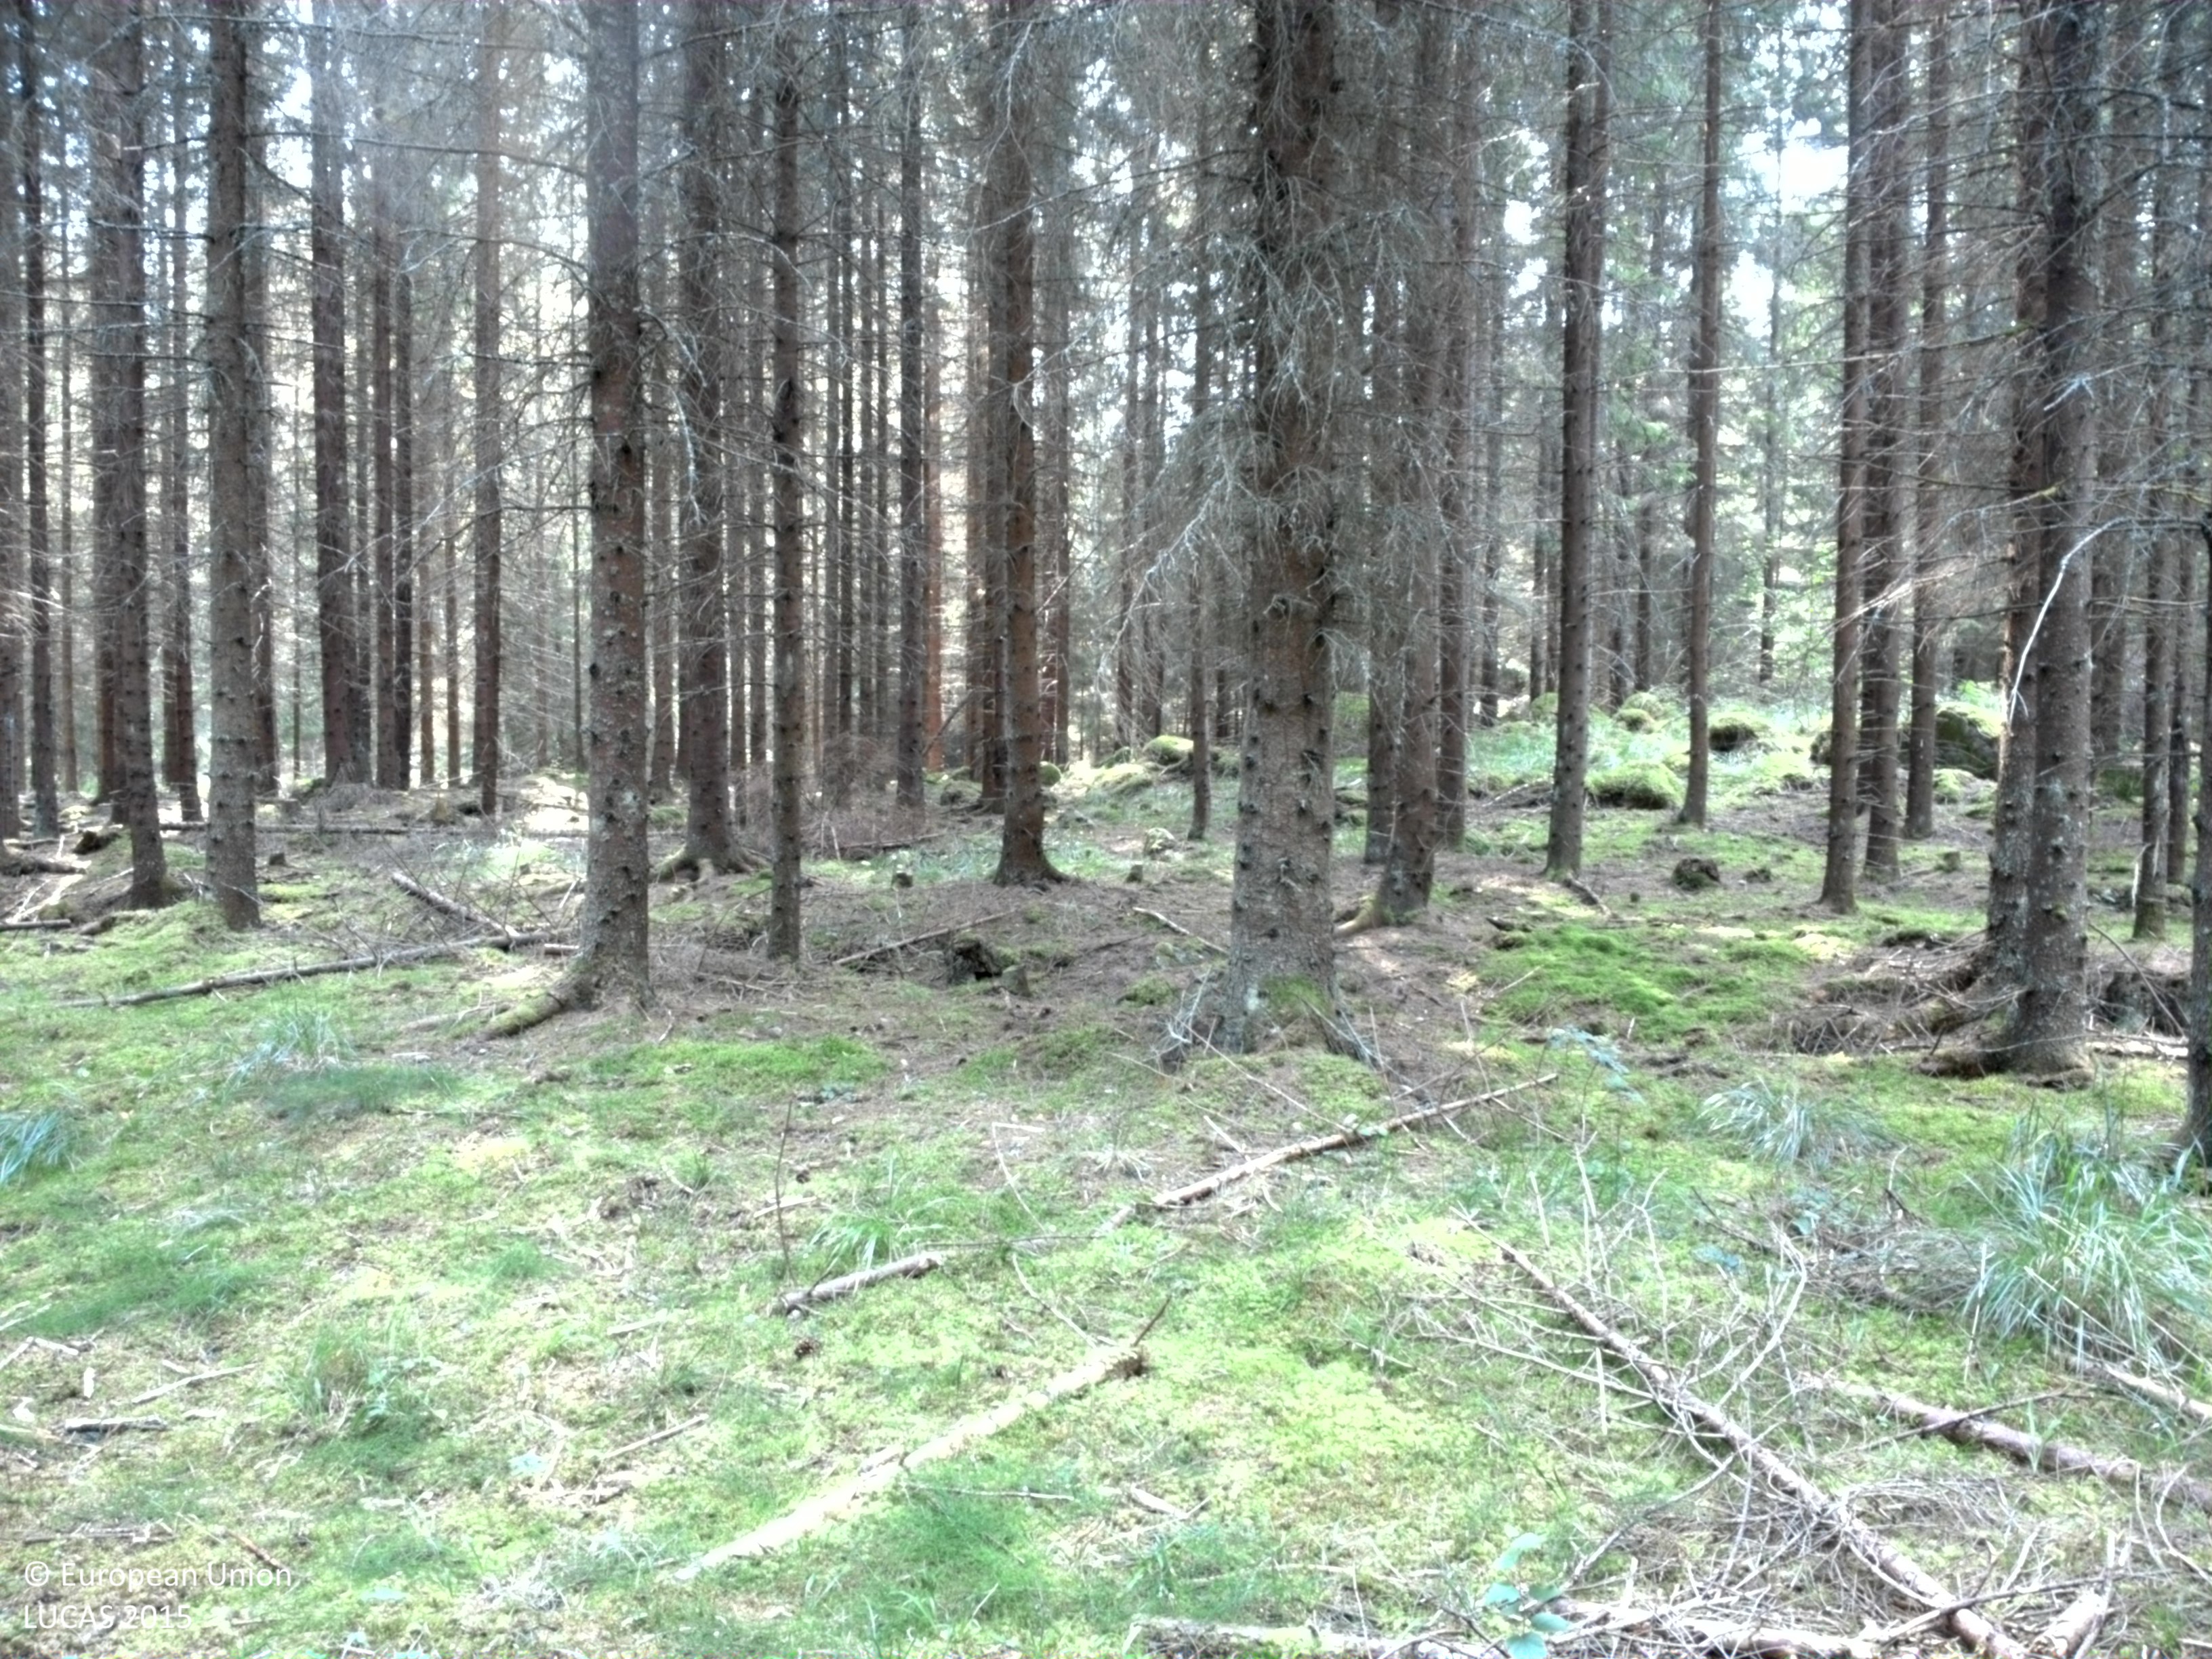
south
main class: Woodland
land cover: Spruce dominated coniferous woodland
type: boreal forest
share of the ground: > 75 %
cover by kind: coniferous forest trees 85 %, lichens and mosses 10 %, herbaceous plants 5 %
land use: Forestry
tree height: > 5 m
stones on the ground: < 10 %
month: August
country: SE
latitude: 60.0703
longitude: 17.5217
